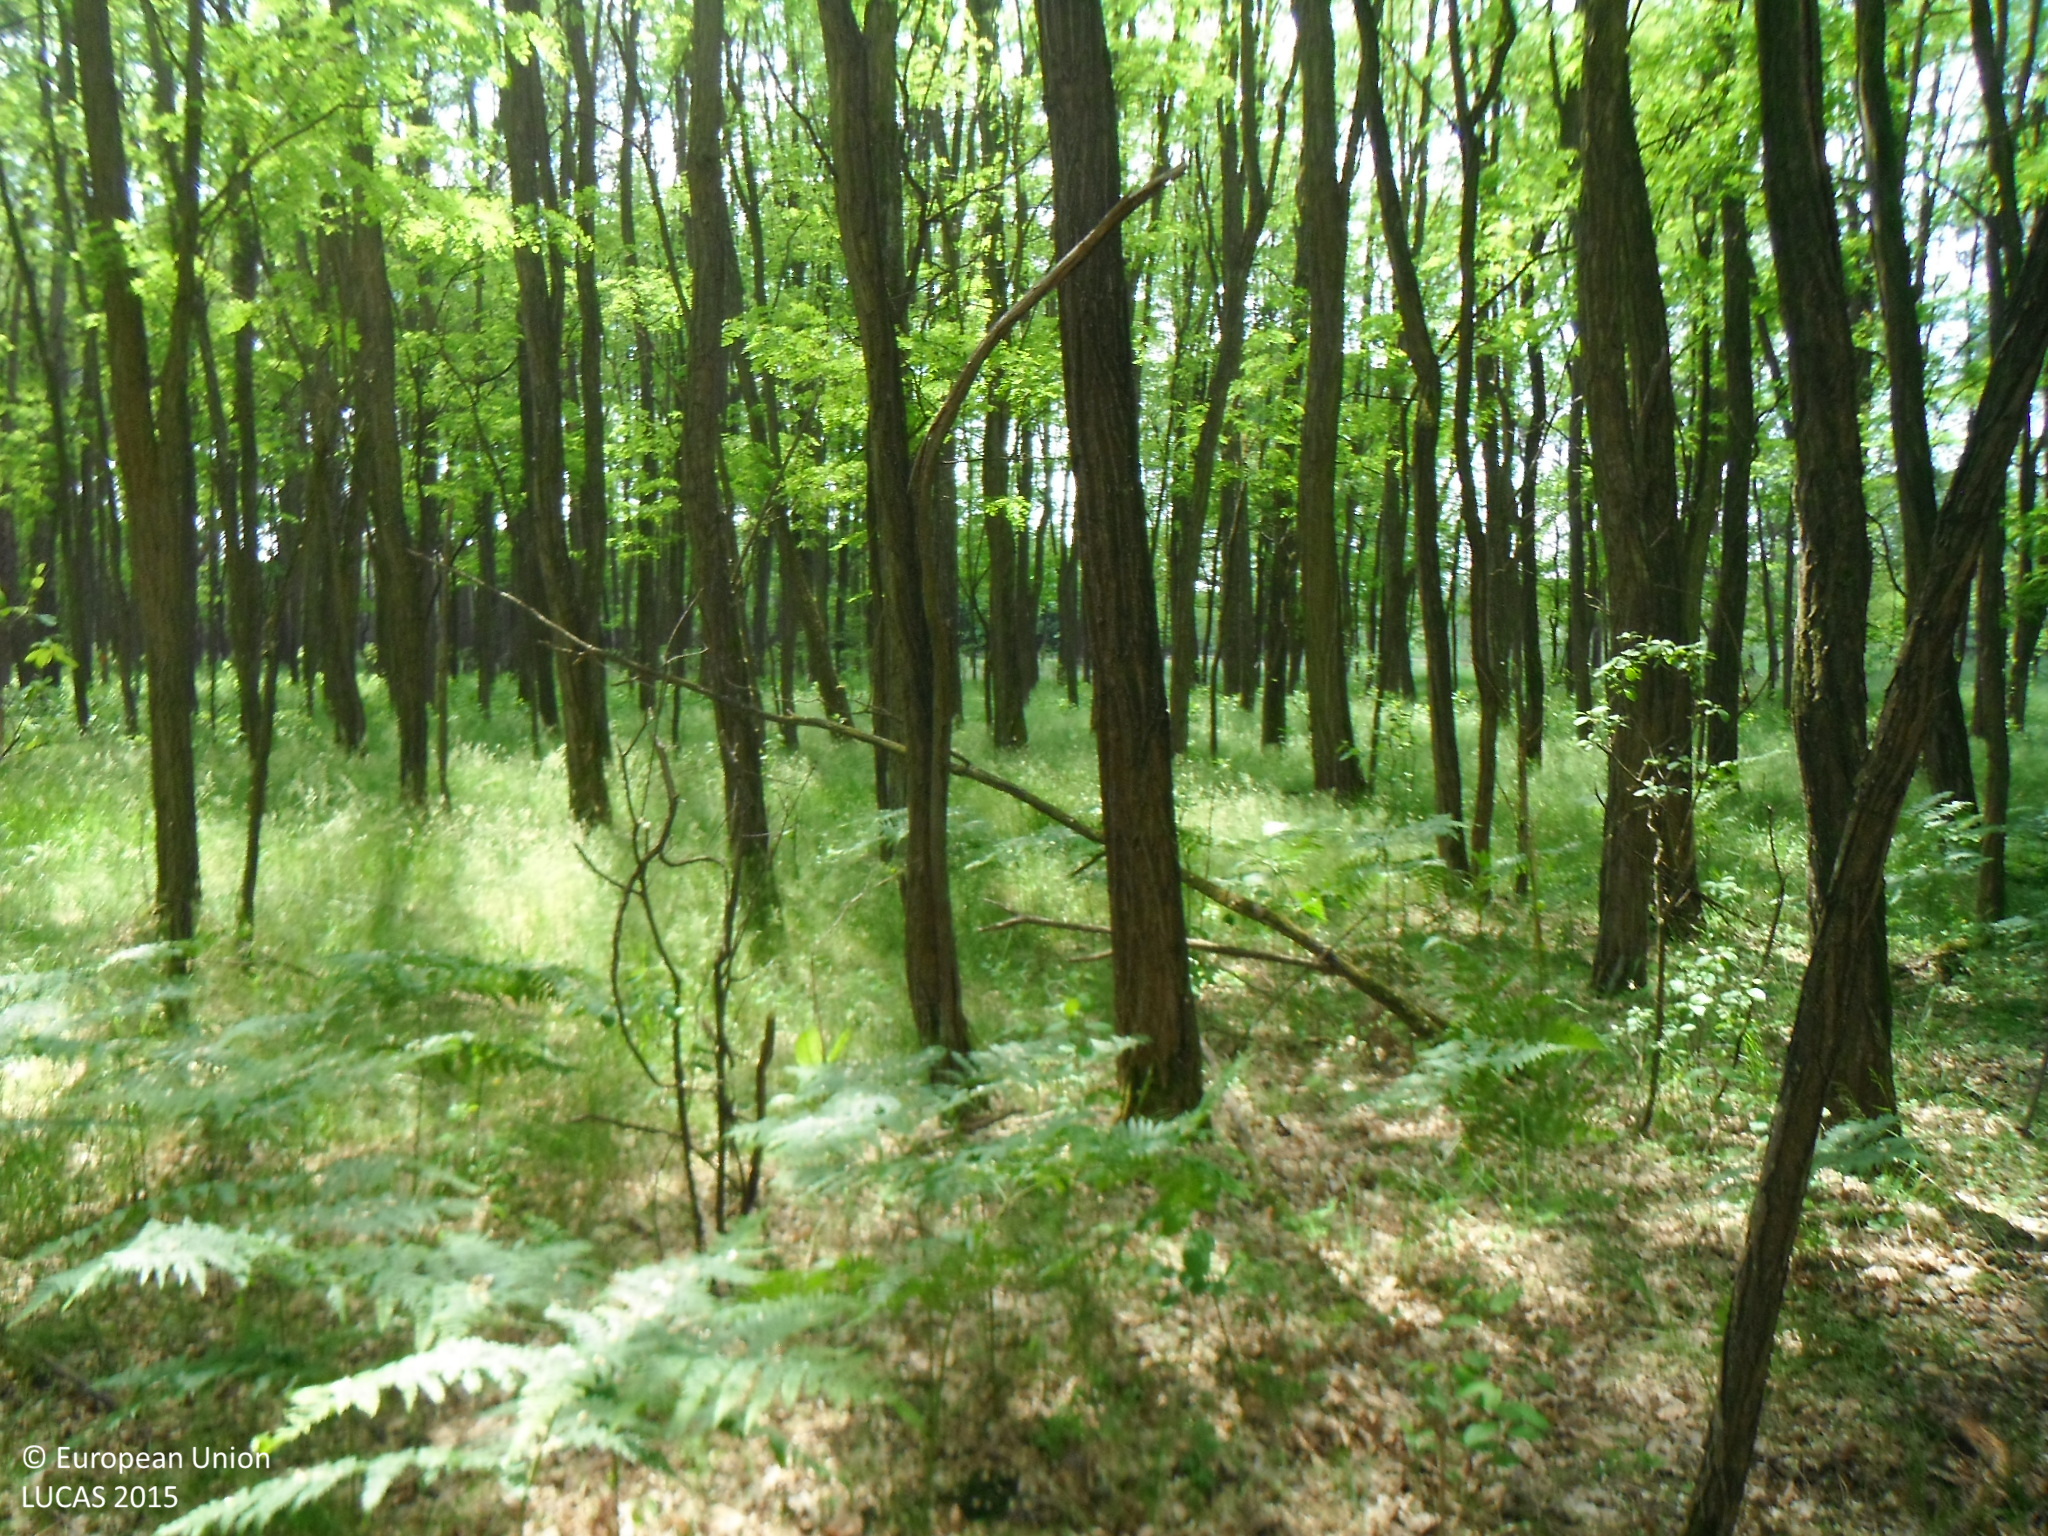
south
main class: Woodland
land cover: Broadleaved woodland
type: exotic forest
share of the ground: > 75 %
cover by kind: broadleaved forest trees 85 %, shrubs 5 %, herbaceous plants 5 %, unconsolidated bare surface 5 %
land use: Forestry
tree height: > 5 m
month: June
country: SK
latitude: 48.5513
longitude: 17.1484
